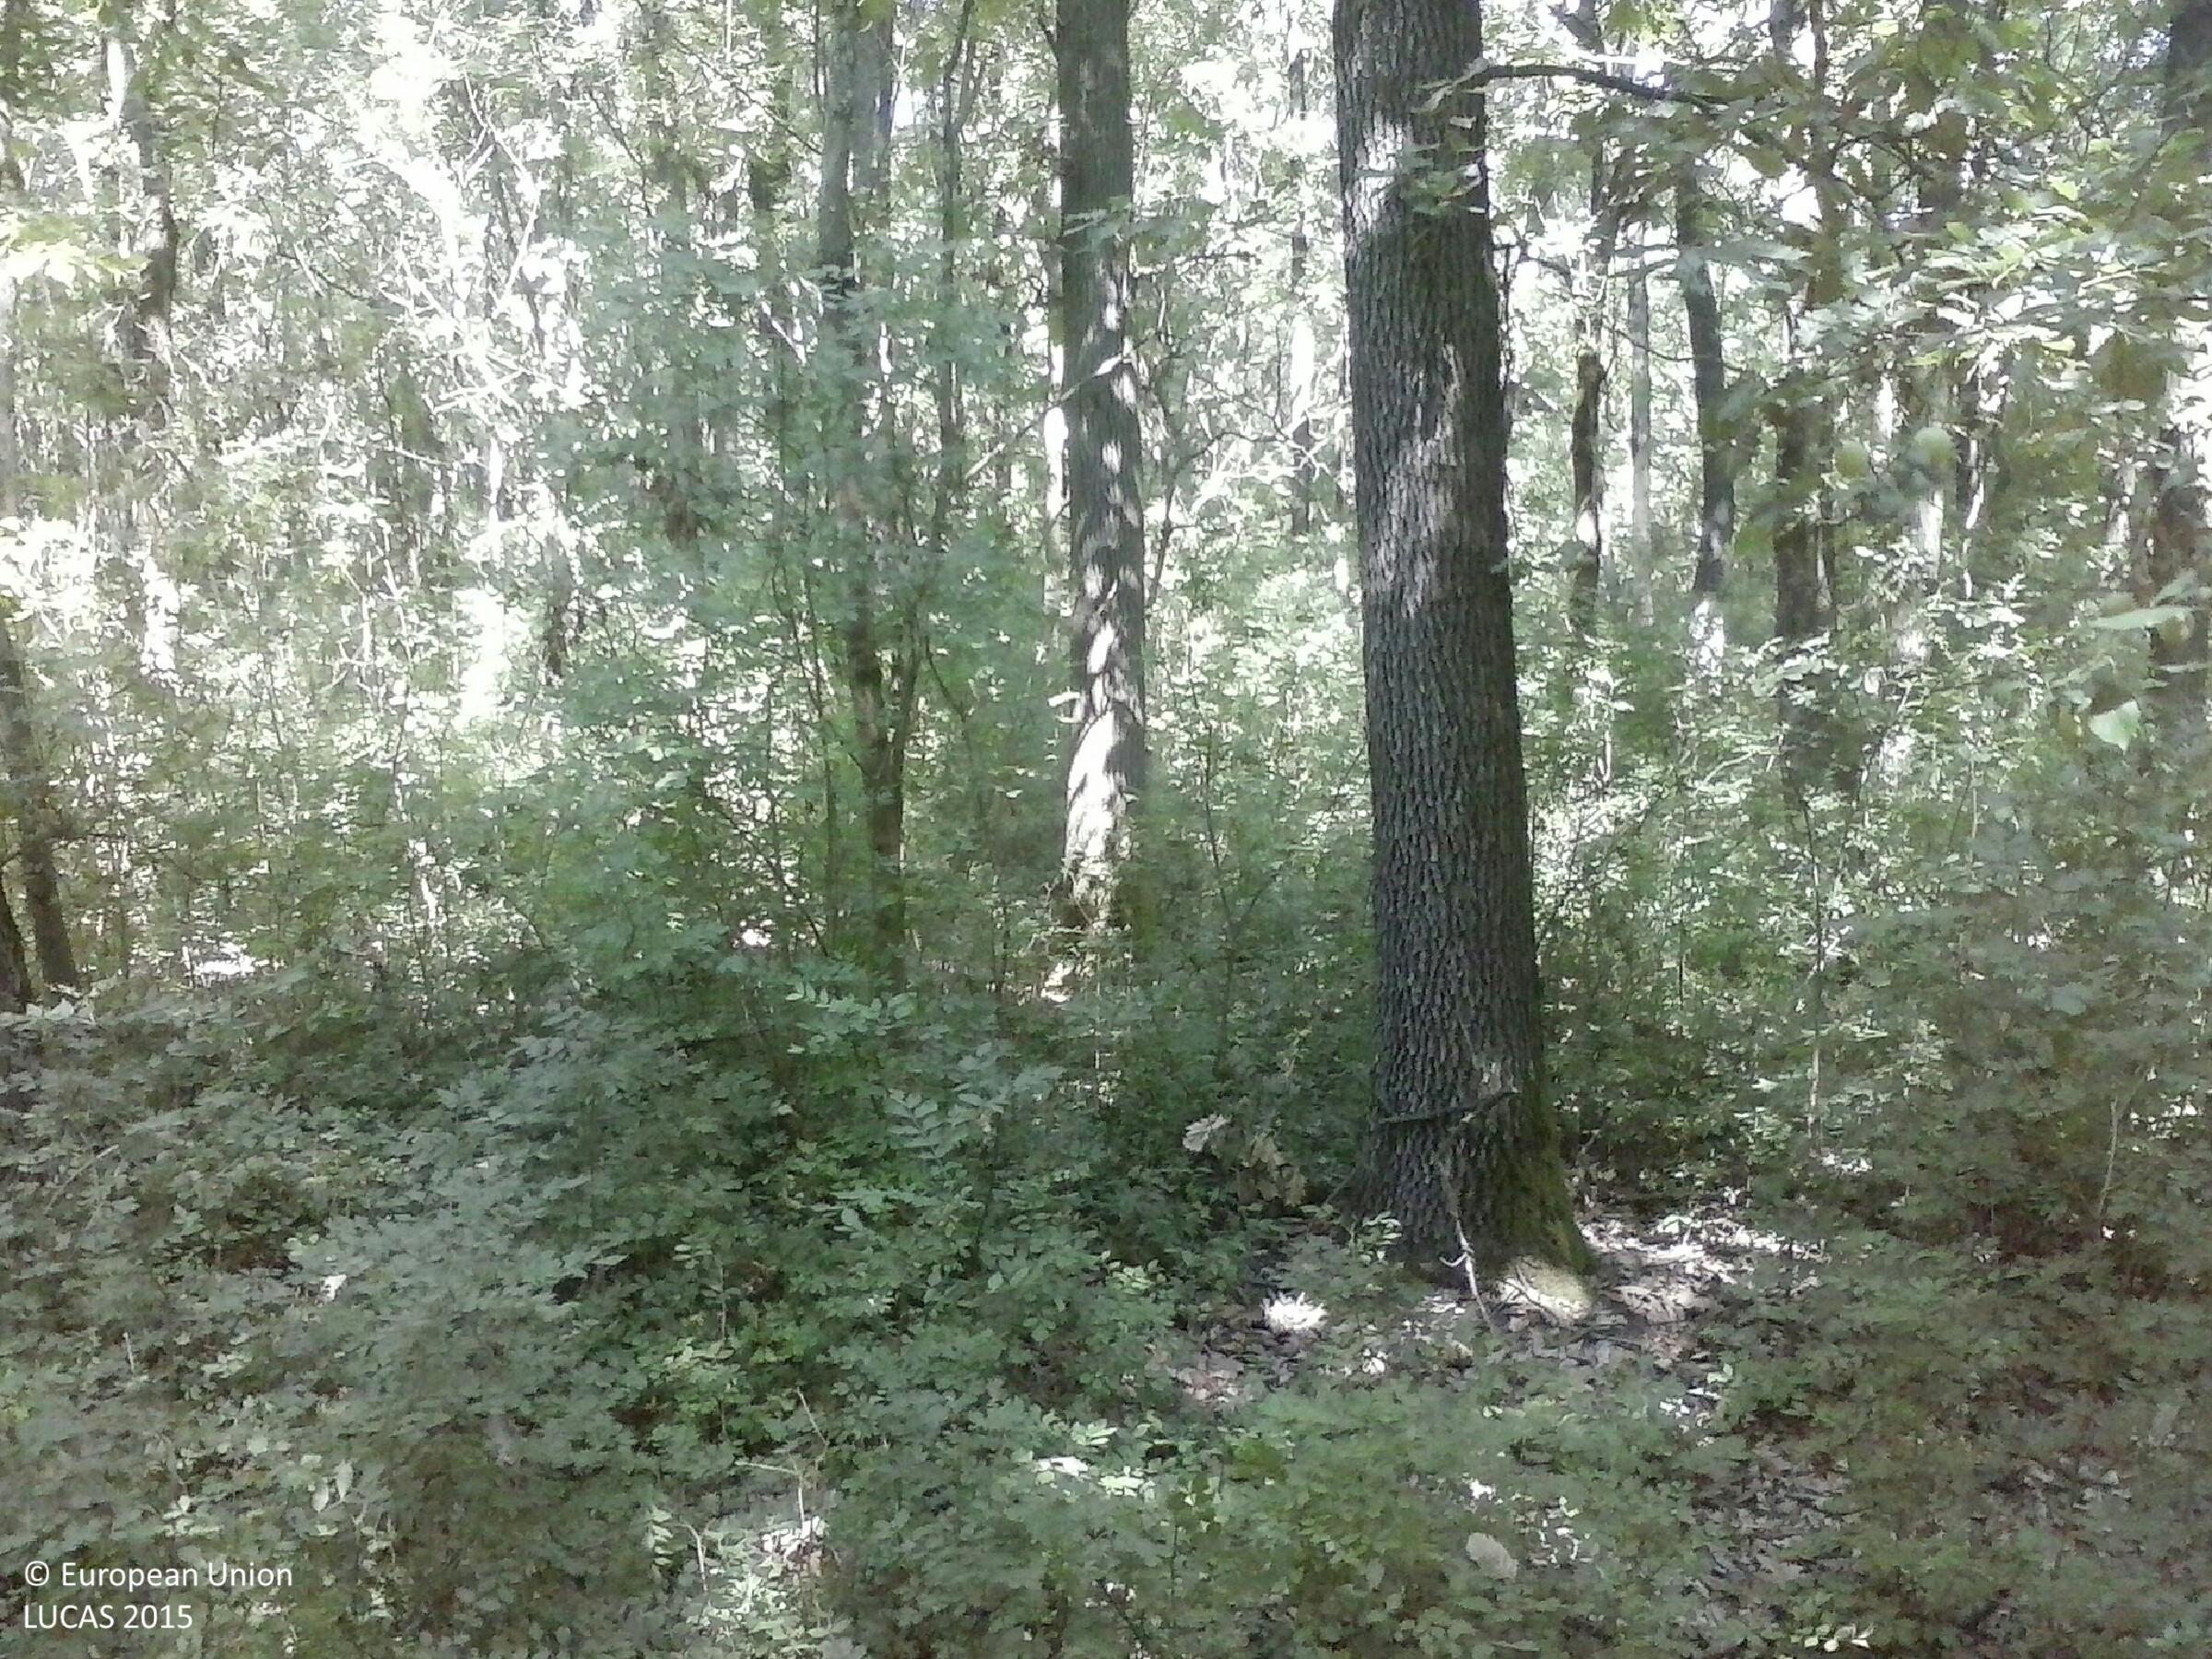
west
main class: Woodland
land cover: Broadleaved woodland
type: exotic forest
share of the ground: > 75 %
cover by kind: broadleaved forest trees 75 %, shrubs 25 %
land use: Forestry
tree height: > 5 m
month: July
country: HU
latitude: 46.5361
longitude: 20.3652
